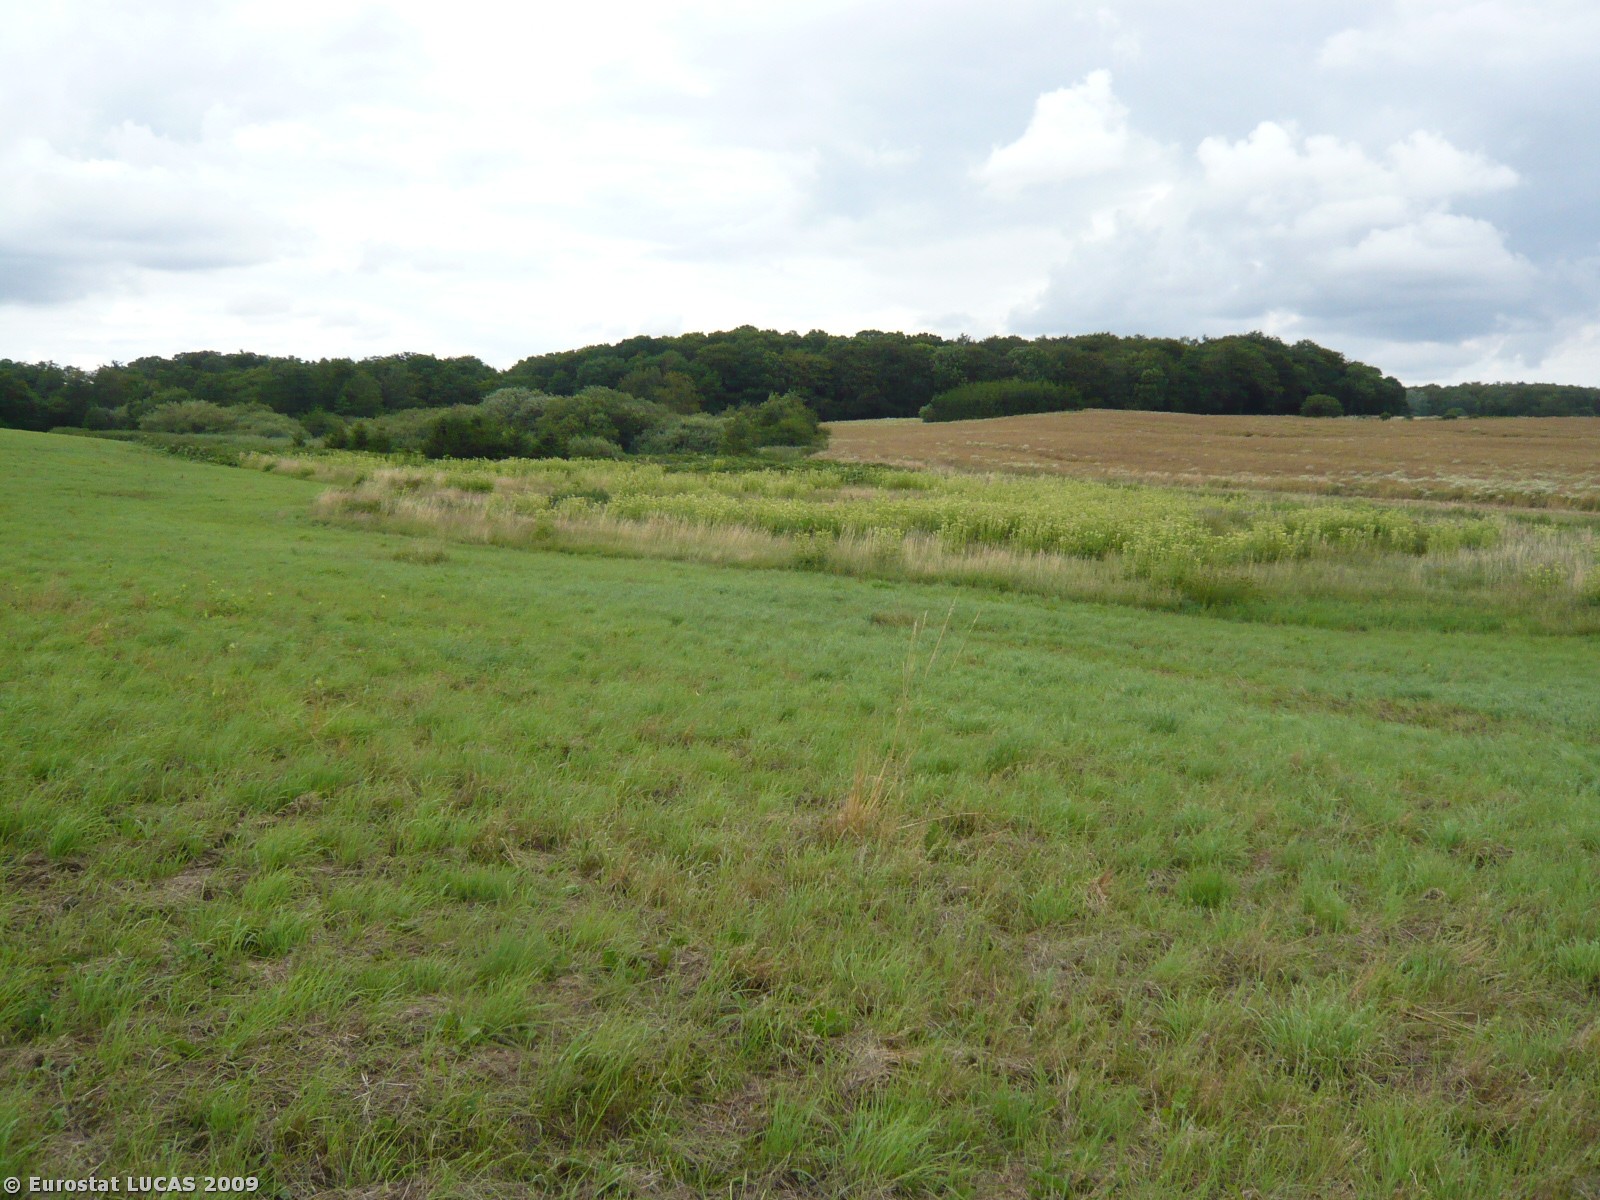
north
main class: Grassland
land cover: Grassland without tree/shrub cover
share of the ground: > 75 %
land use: Agriculture (excluding fallow land and kitchen gardens)
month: July
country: DK
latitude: 55.5252
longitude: 11.9785
